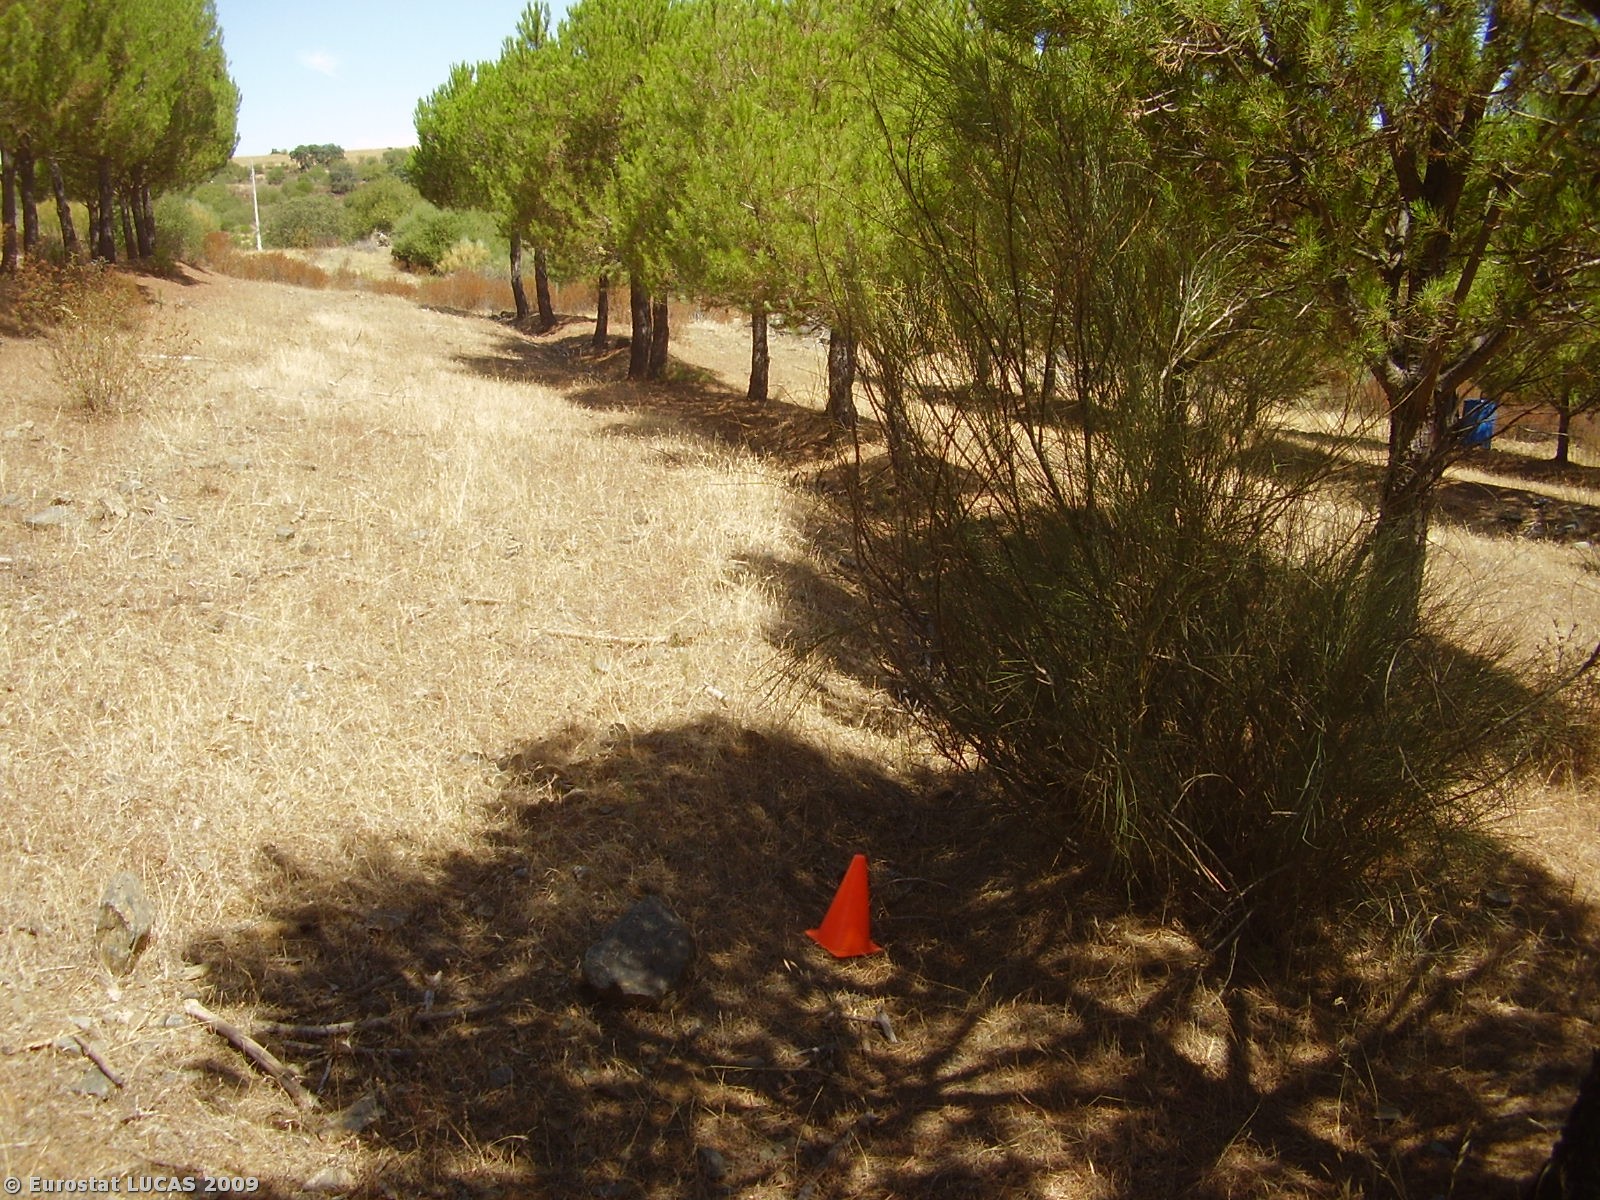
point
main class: Woodland
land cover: Coniferous woodland
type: coniferous forest of the mediterranean region
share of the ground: 10 - 25 %
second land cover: Spontaneously vegetated surfaces
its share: > 75 %
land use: Forestry
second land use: Fallow land
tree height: > 5 m
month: August
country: PT
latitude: 37.9247
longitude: -7.6893
